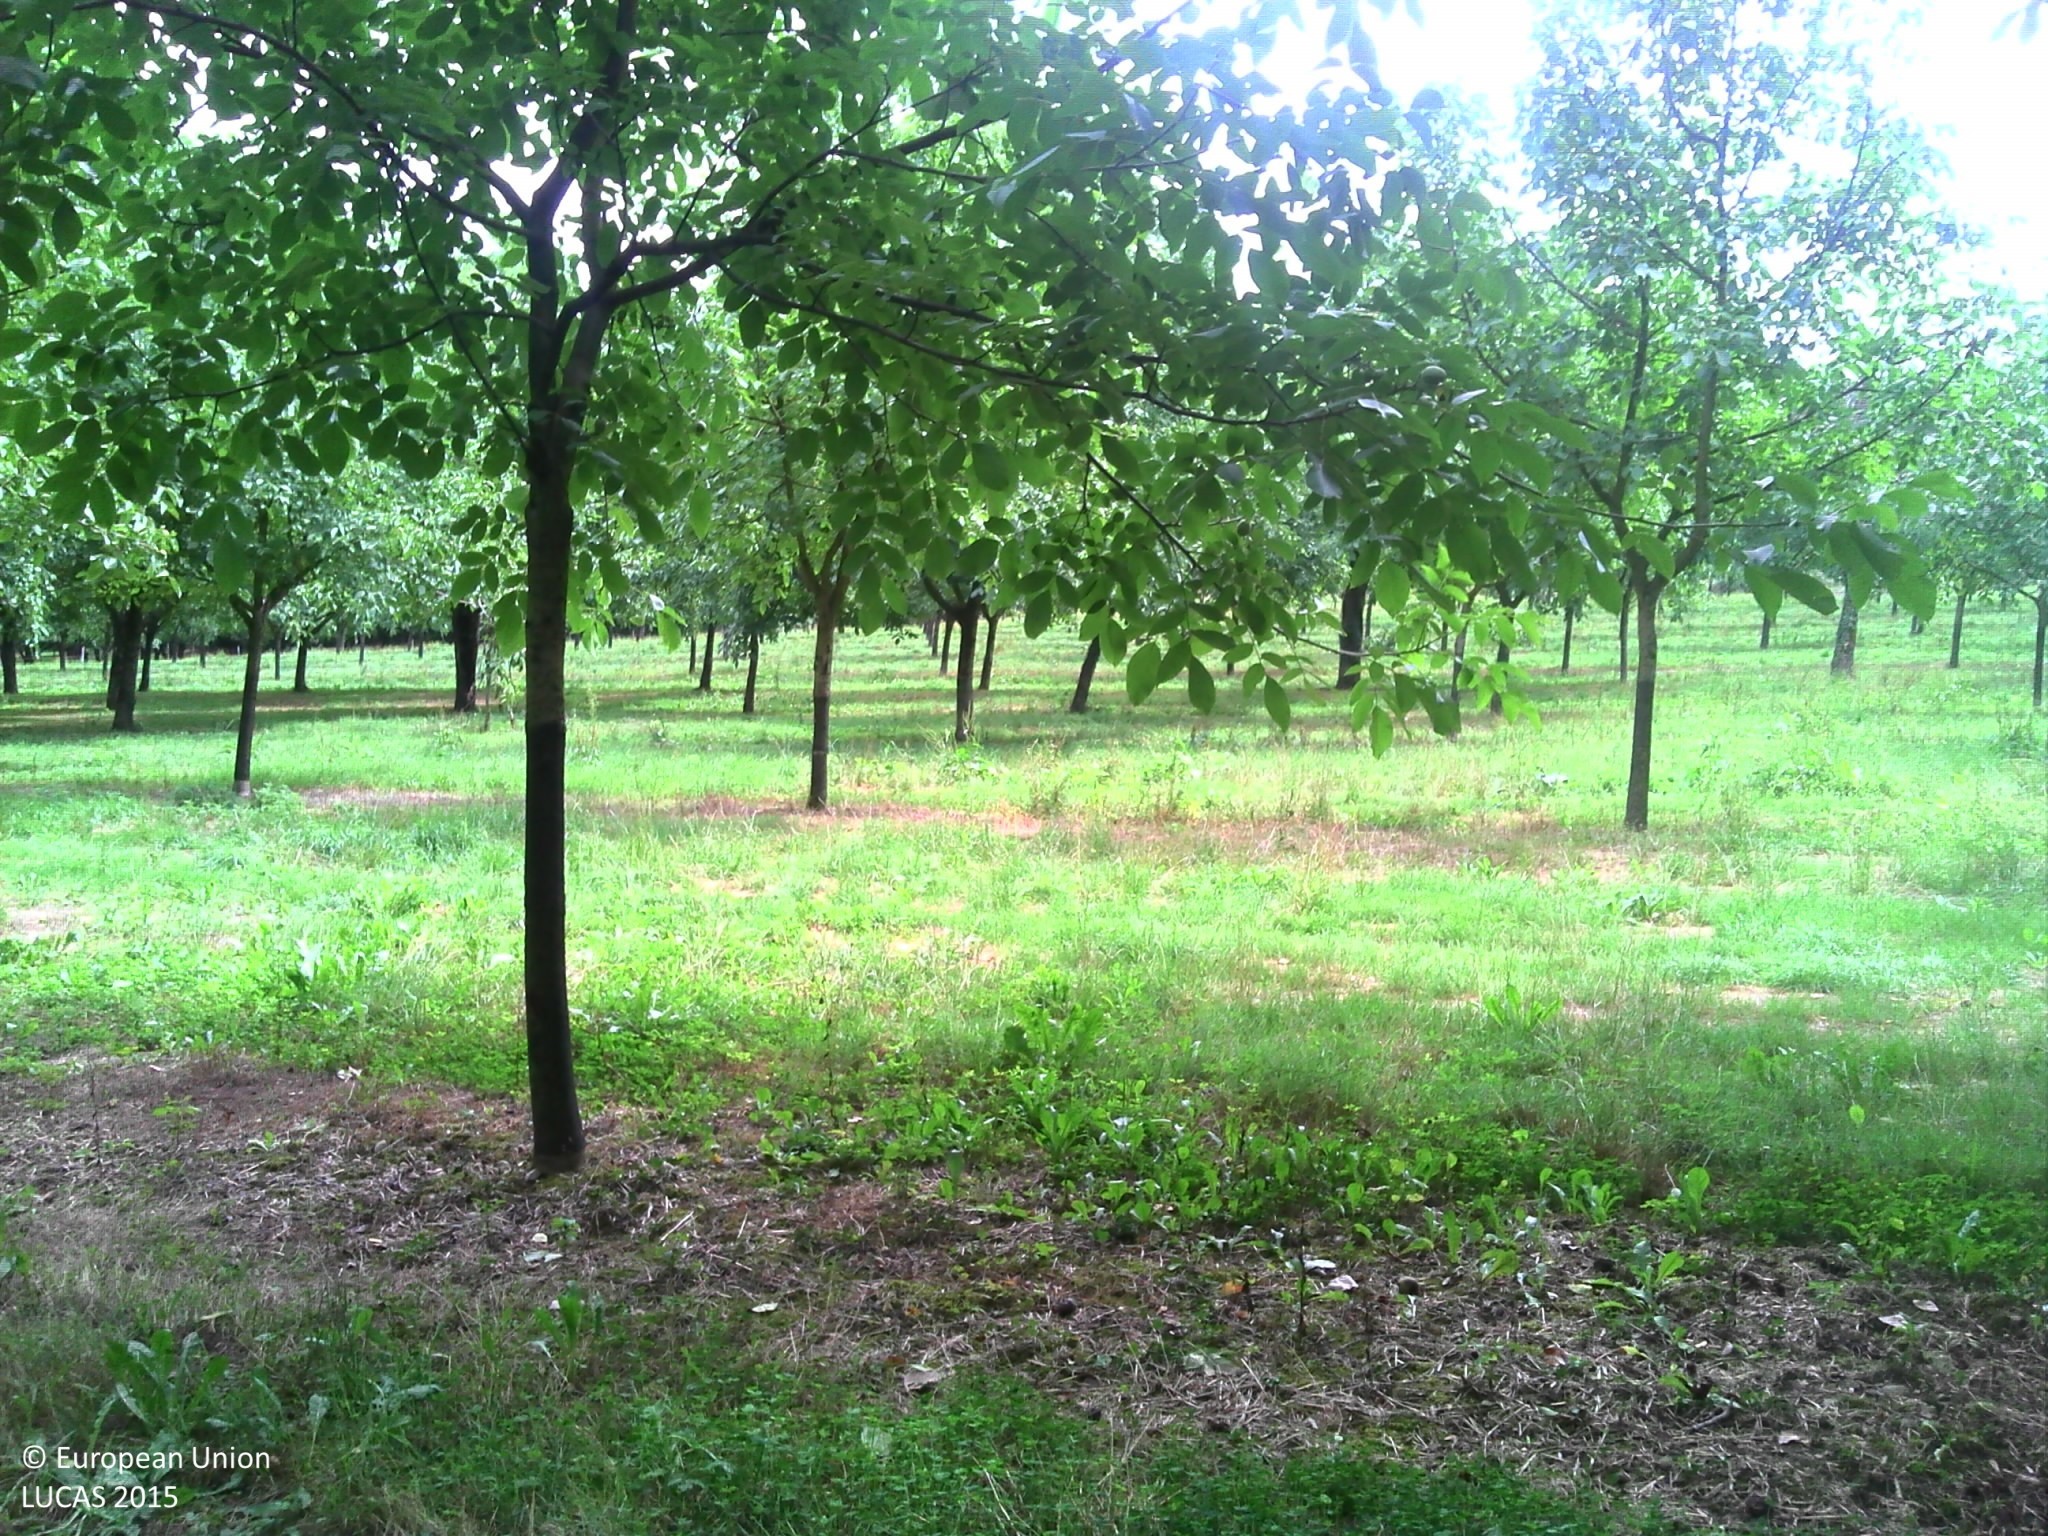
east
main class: Grassland
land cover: Grassland without tree/shrub cover
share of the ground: > 75 %
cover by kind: herbaceous plants 100 %
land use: Agriculture (excluding fallow land and kitchen gardens)
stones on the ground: < 10 %
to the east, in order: Grassland without tree/shrub cover; Fences; Ditches and canals; Lines of trees; Nuts trees; Fences; Nuts trees
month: August
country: FR
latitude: 45.2442
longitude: 5.4570
